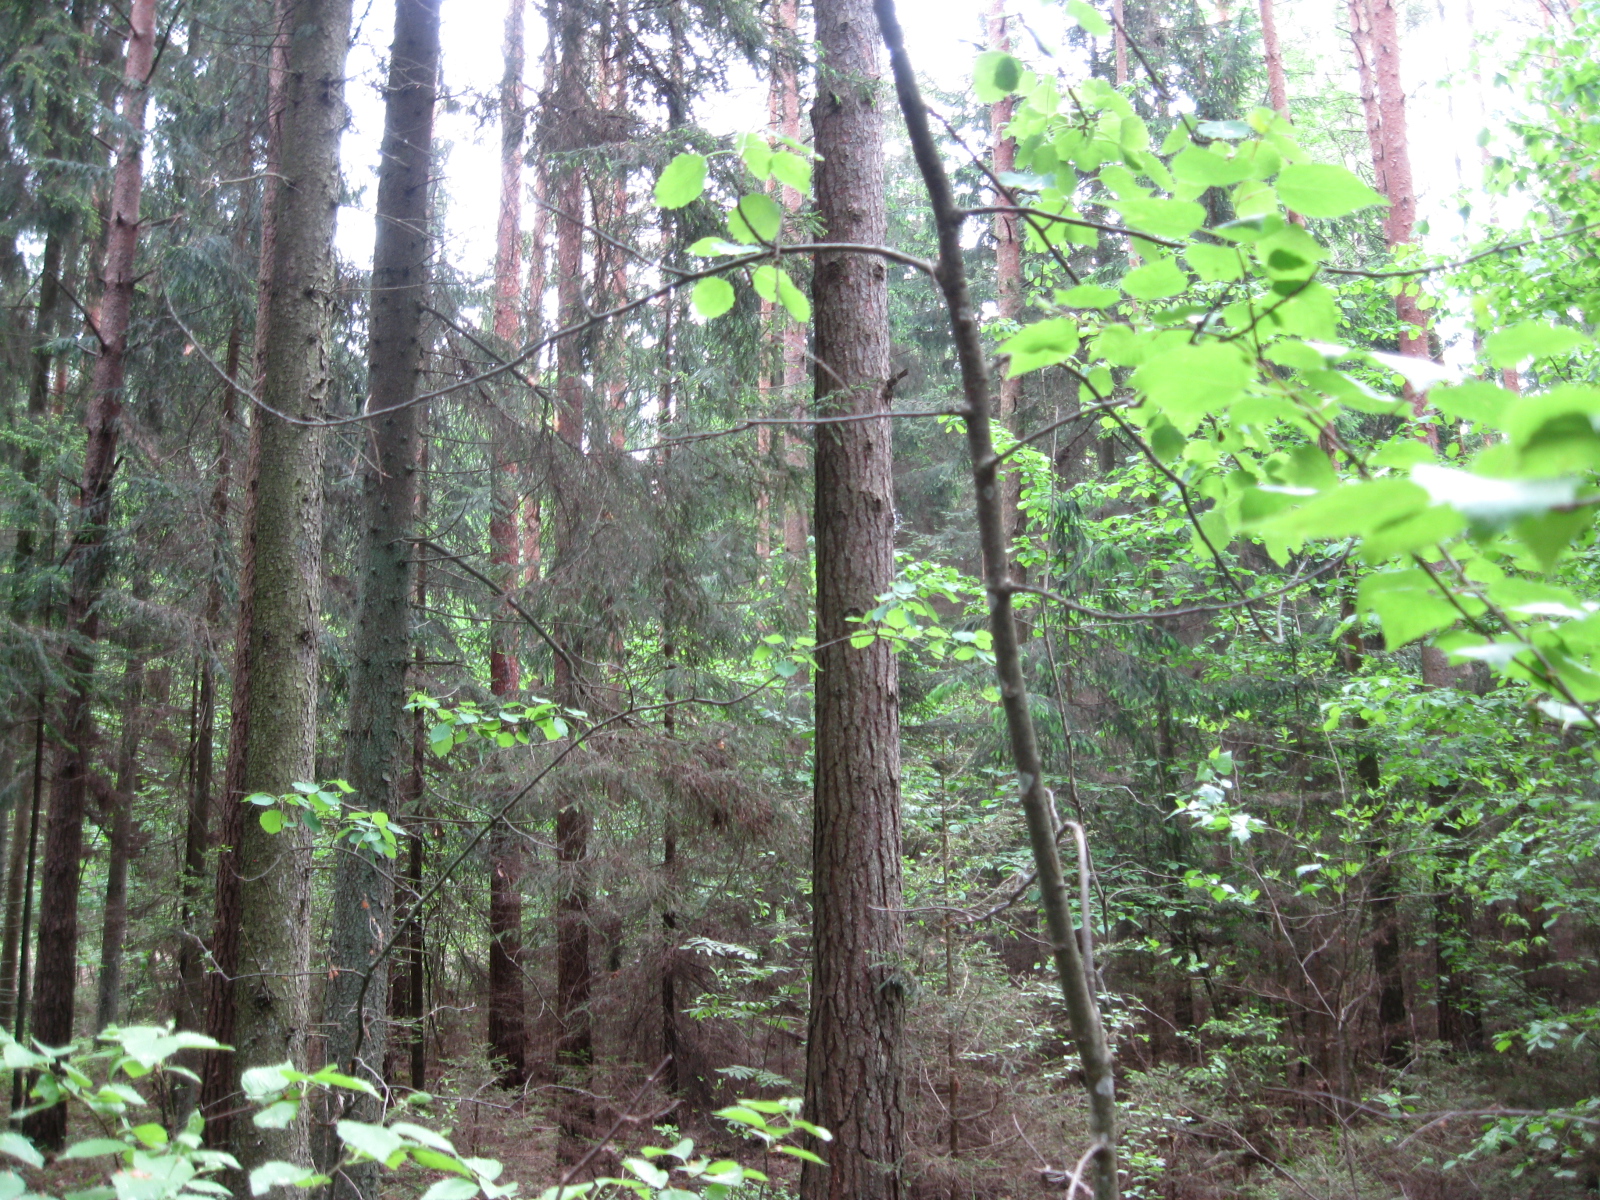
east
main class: Woodland
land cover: Other coniferous woodland
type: hemiboreal forest and nemoral coniferous forest and mixed broadleaved-coniferous forest
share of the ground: > 75 %
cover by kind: coniferous forest trees 70 %, broadleaved forest trees 10 %, lichens and mosses 10 %, shrubs 5 %, herbaceous plants 5 %
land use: Forestry
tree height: > 5 m
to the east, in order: Other coniferous woodland; Spruce dominated coniferous woodland; Ditches and canals; Spruce dominated mixed woodland; Tracks; Other mixed woodland; Ditches and canals; Spruce dominated mixed woodland; Tracks; Spruce dominated coniferous woodland; Other mixed woodland; Spruce dominated coniferous woodland
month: June
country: LT
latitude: 55.9801
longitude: 24.1784
